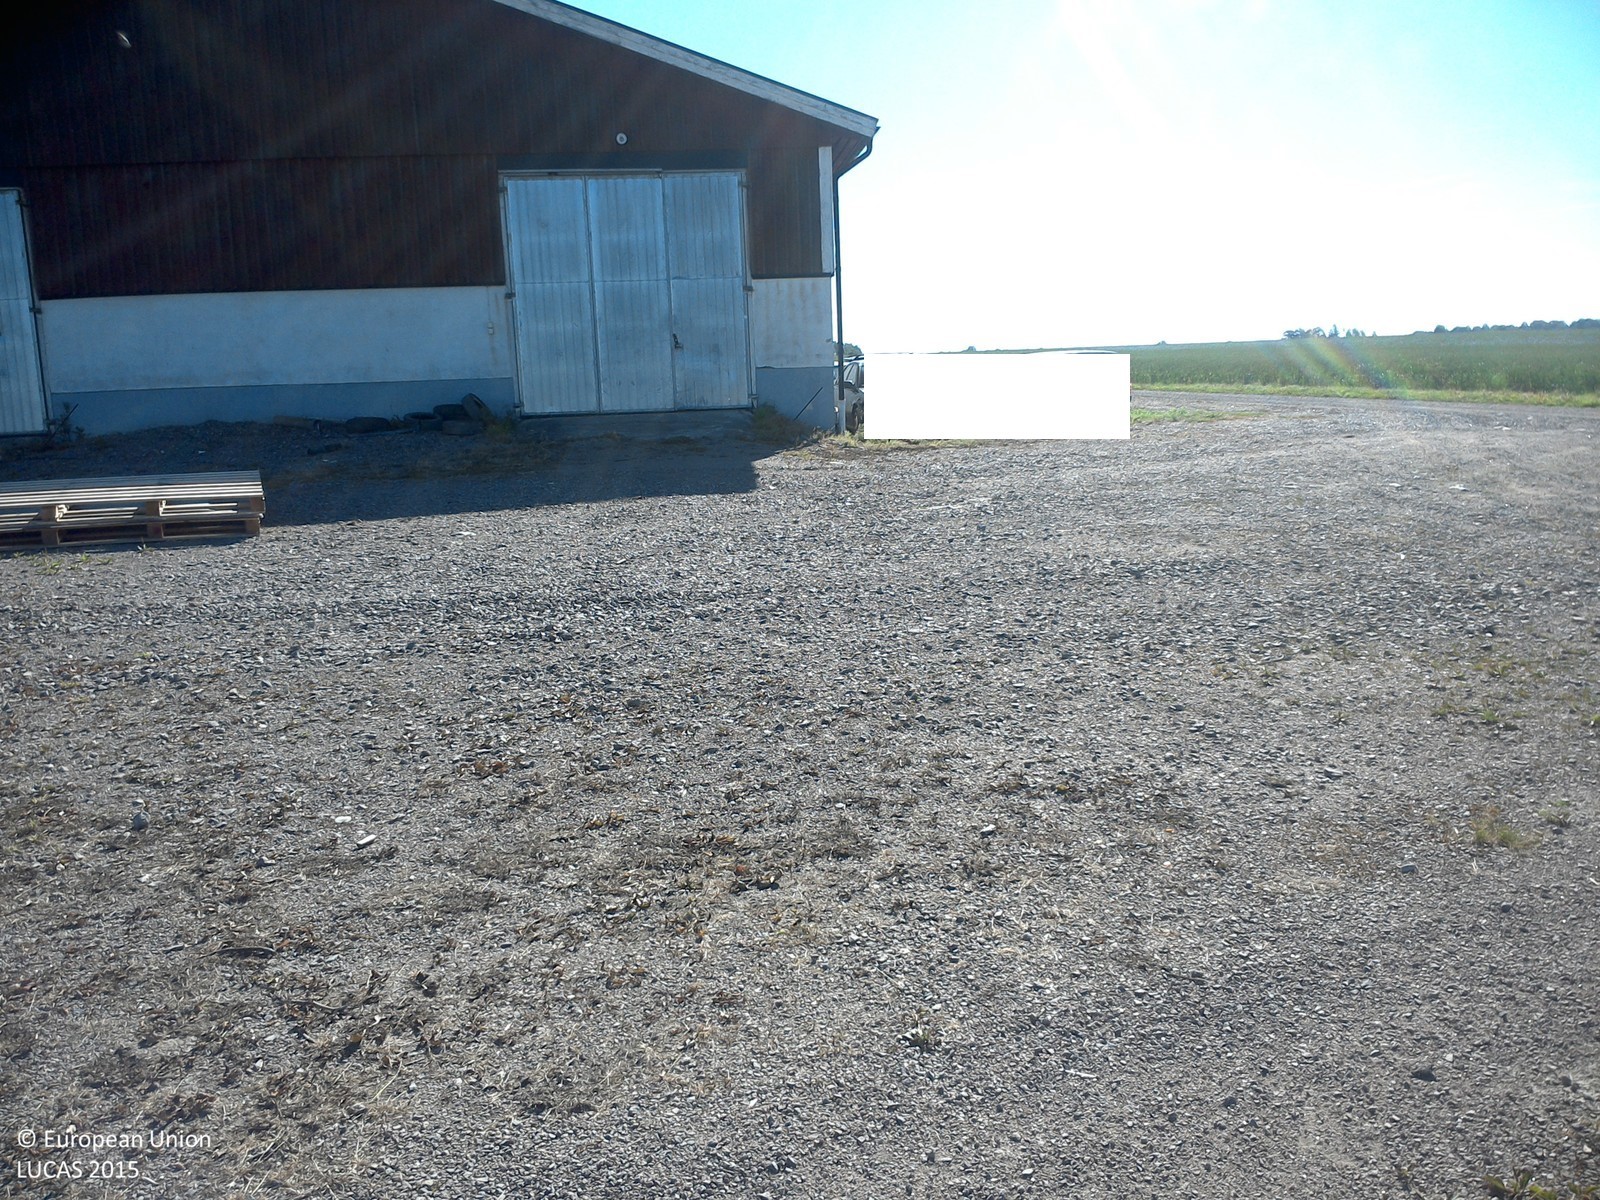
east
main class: Cropland
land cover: Dry pulses
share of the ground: > 75 %
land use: Agriculture (excluding fallow land and kitchen gardens)
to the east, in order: Dry pulses; Grass margins; Paved roads, cycling and walking lanes; Other bare soil; Artificial constructions in urban areas; Common wheat; Grass margins; Paved roads, cycling and walking lanes; Grass margins; Common wheat
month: July
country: SE
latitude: 58.4042
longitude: 15.2820
